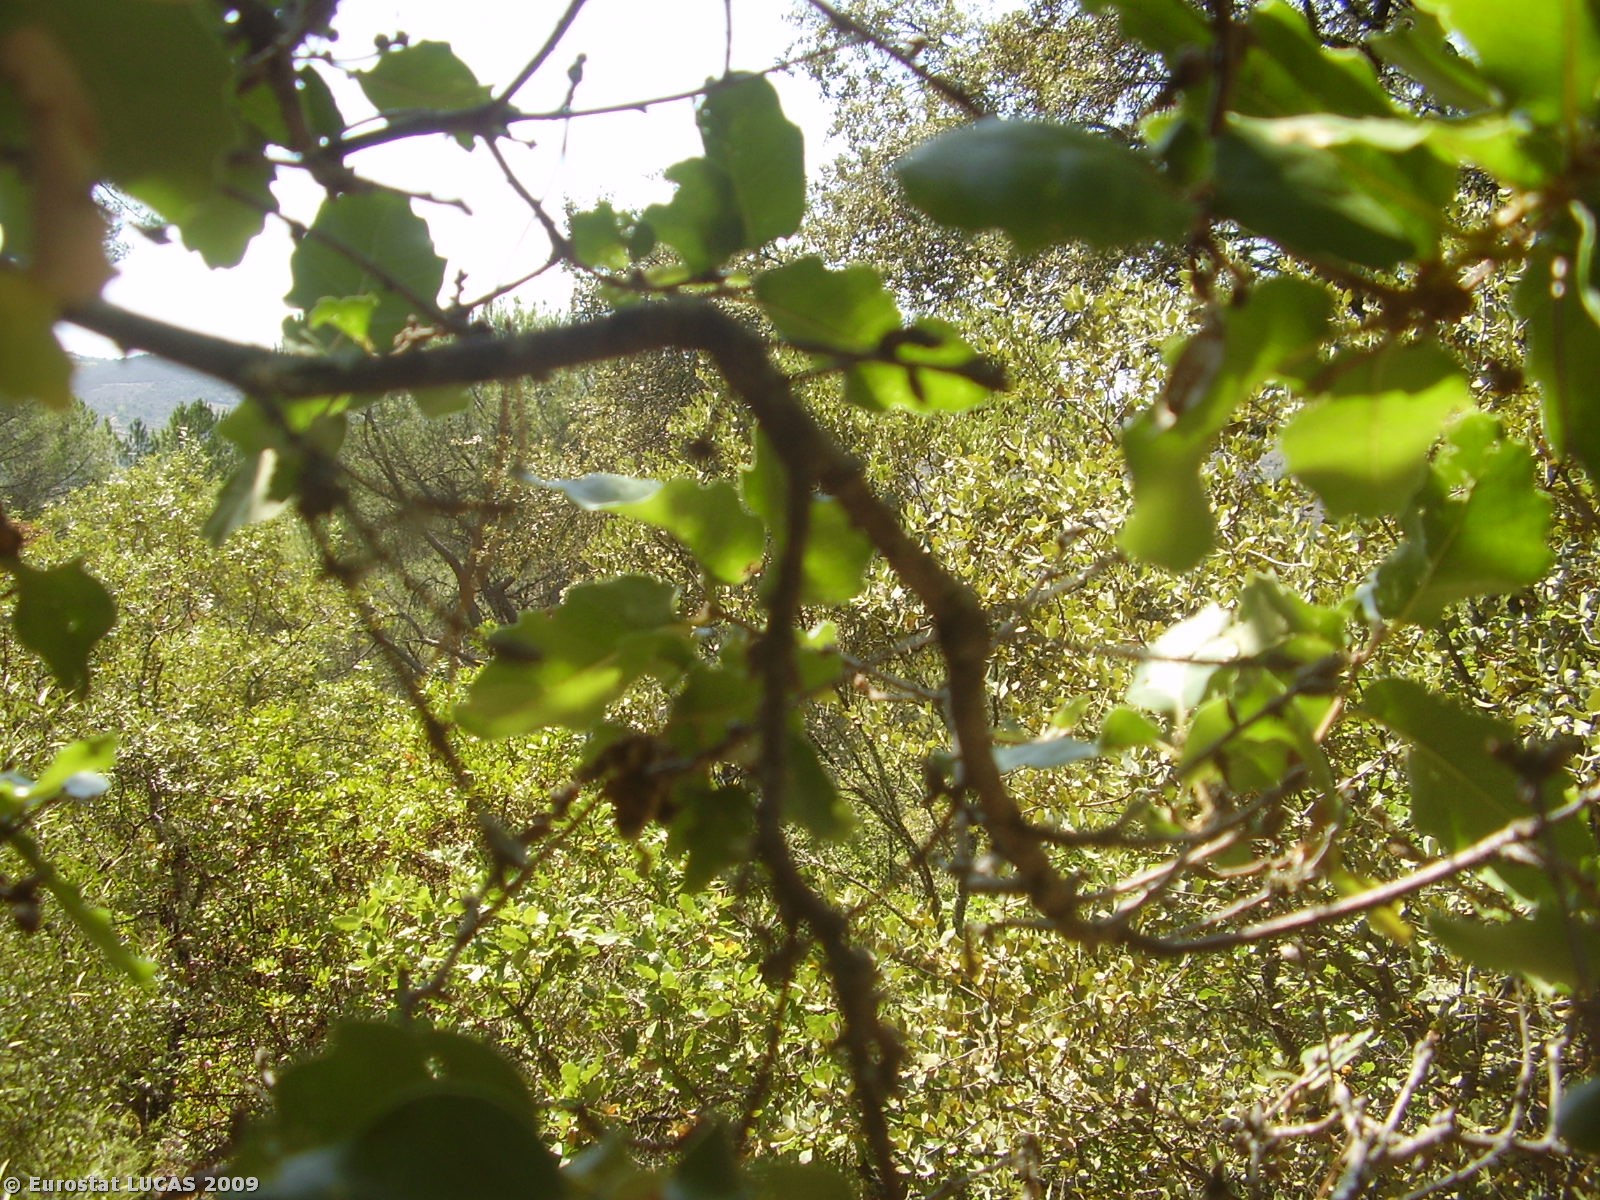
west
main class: Woodland
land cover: Mixed woodland
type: mesophytic deciduous forest
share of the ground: 10 - 25 %
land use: Forestry
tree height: > 5 m
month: August
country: PT
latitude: 41.4003
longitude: -7.0390
